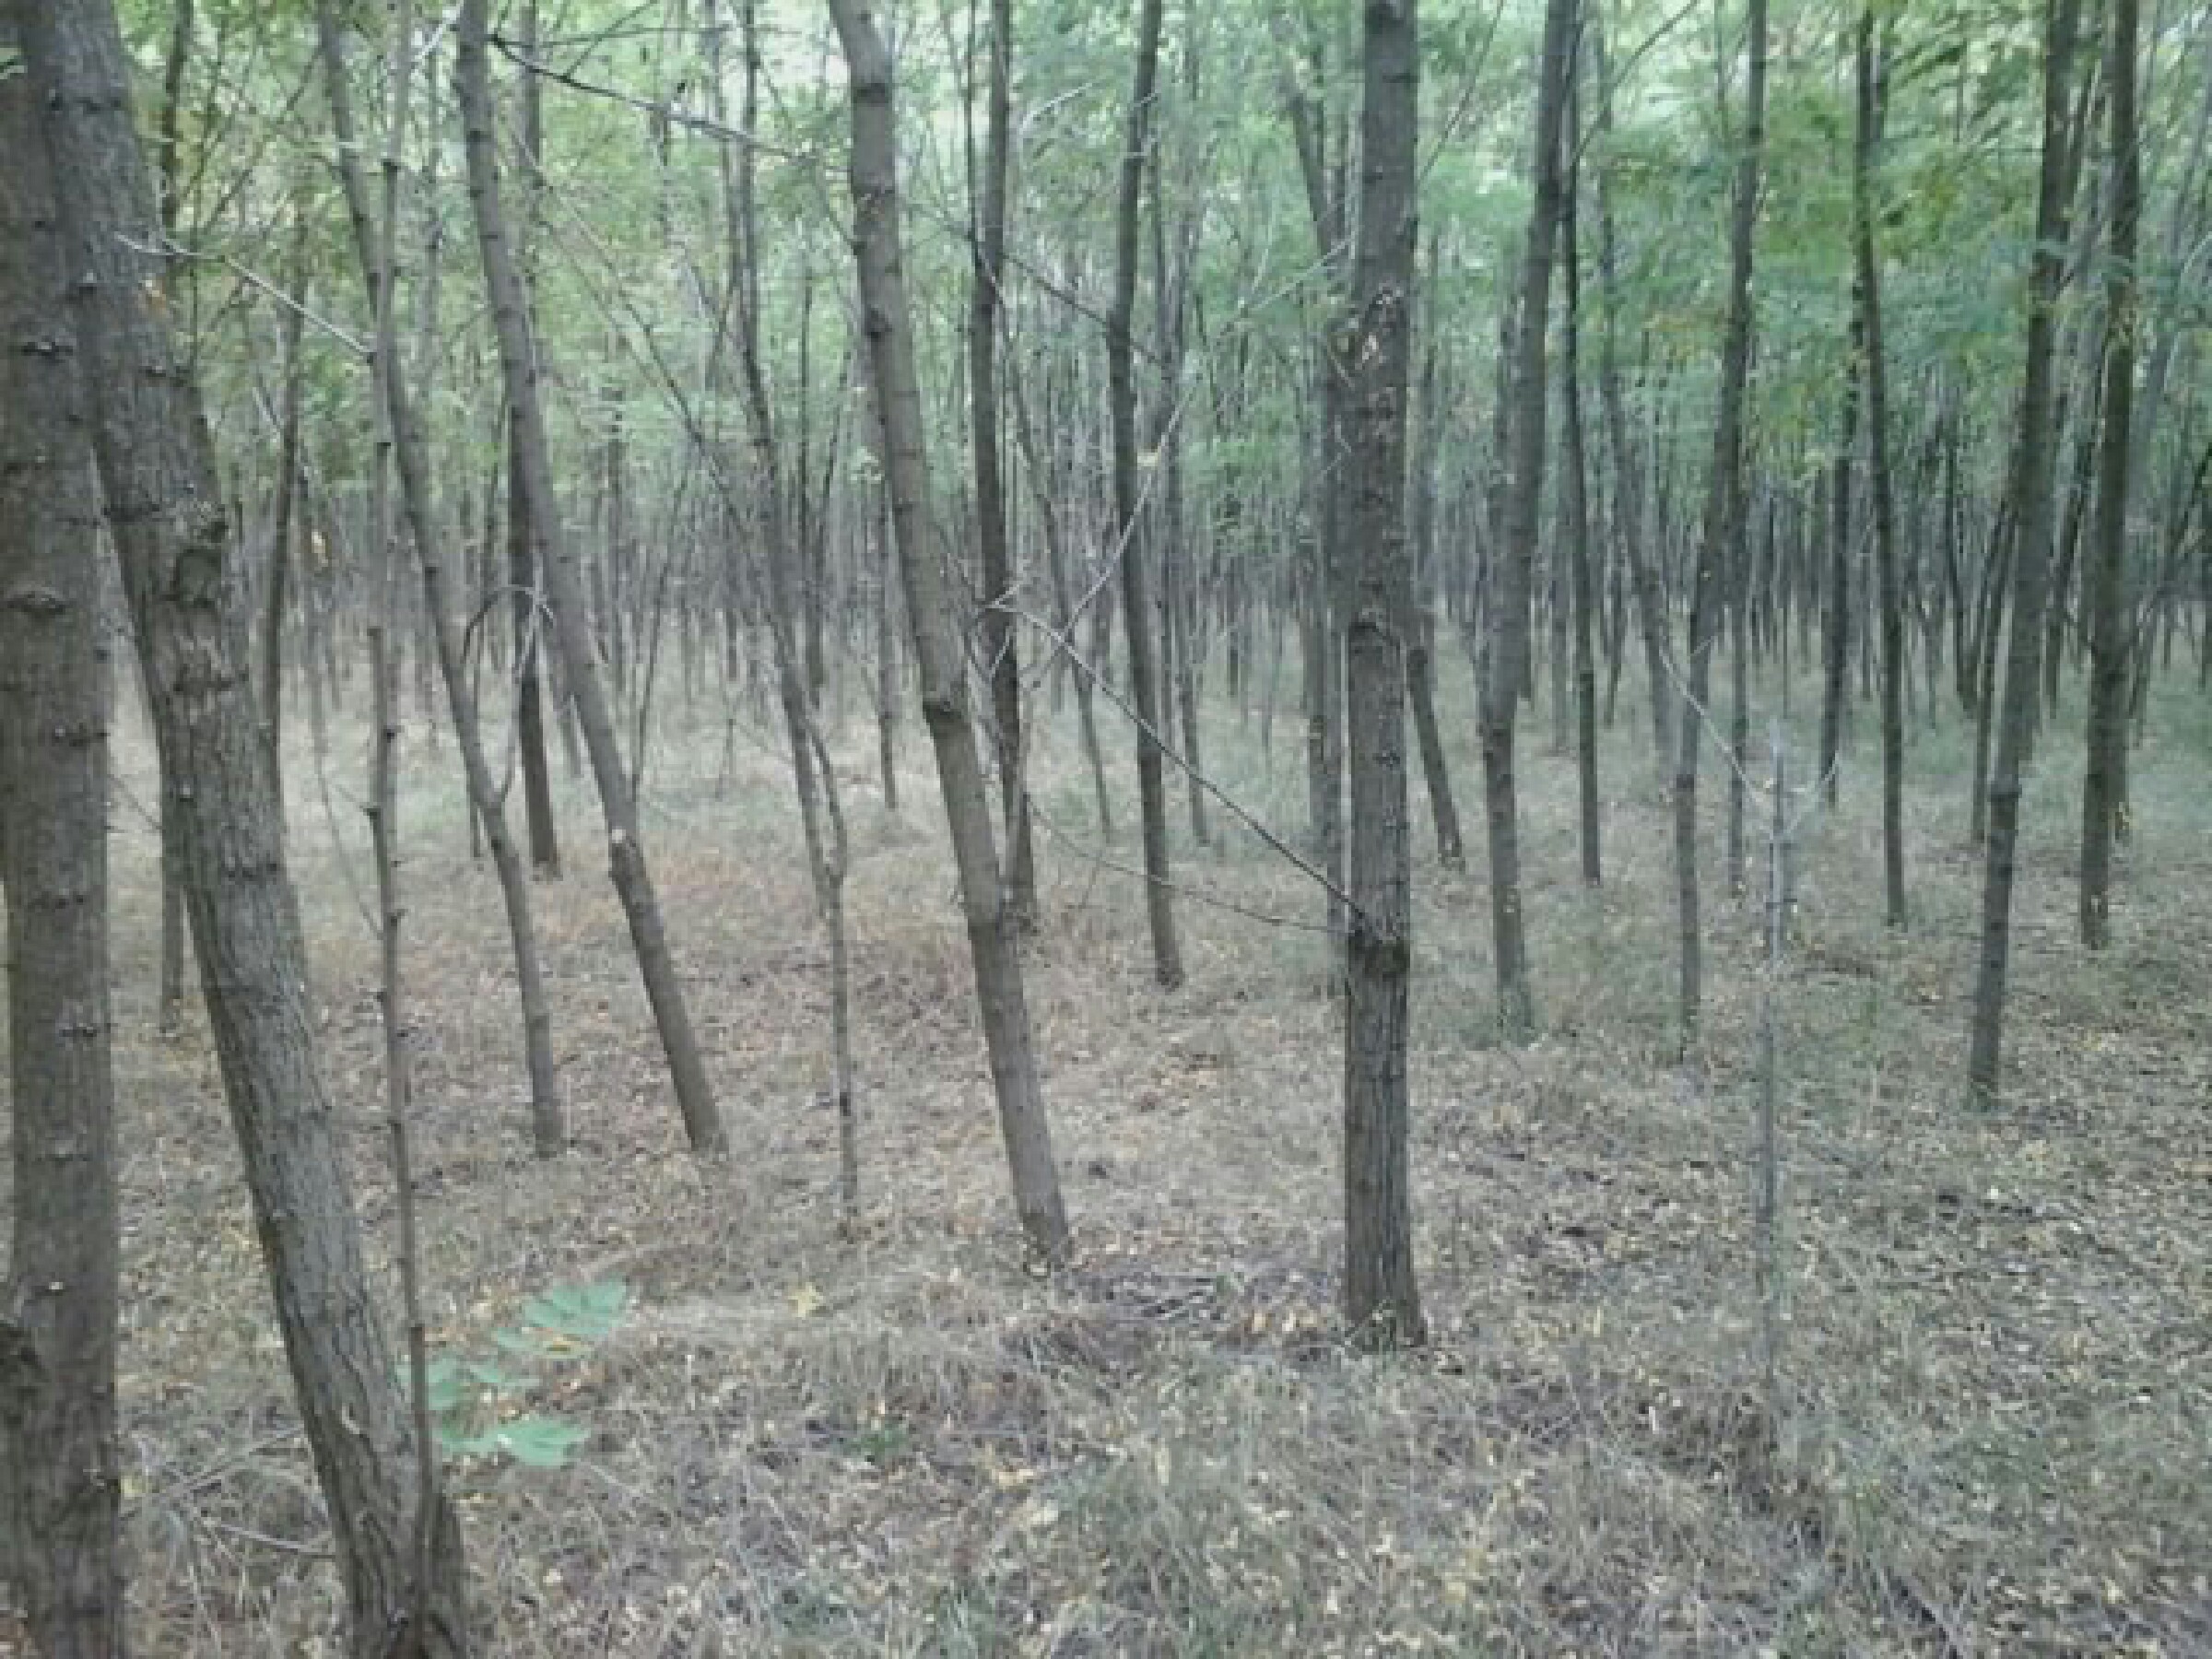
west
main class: Woodland
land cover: Broadleaved woodland
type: exotic forest
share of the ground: > 75 %
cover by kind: broadleaved forest trees 100 %
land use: Forestry
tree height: > 5 m
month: July
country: HU
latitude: 47.8448
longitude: 19.3351
